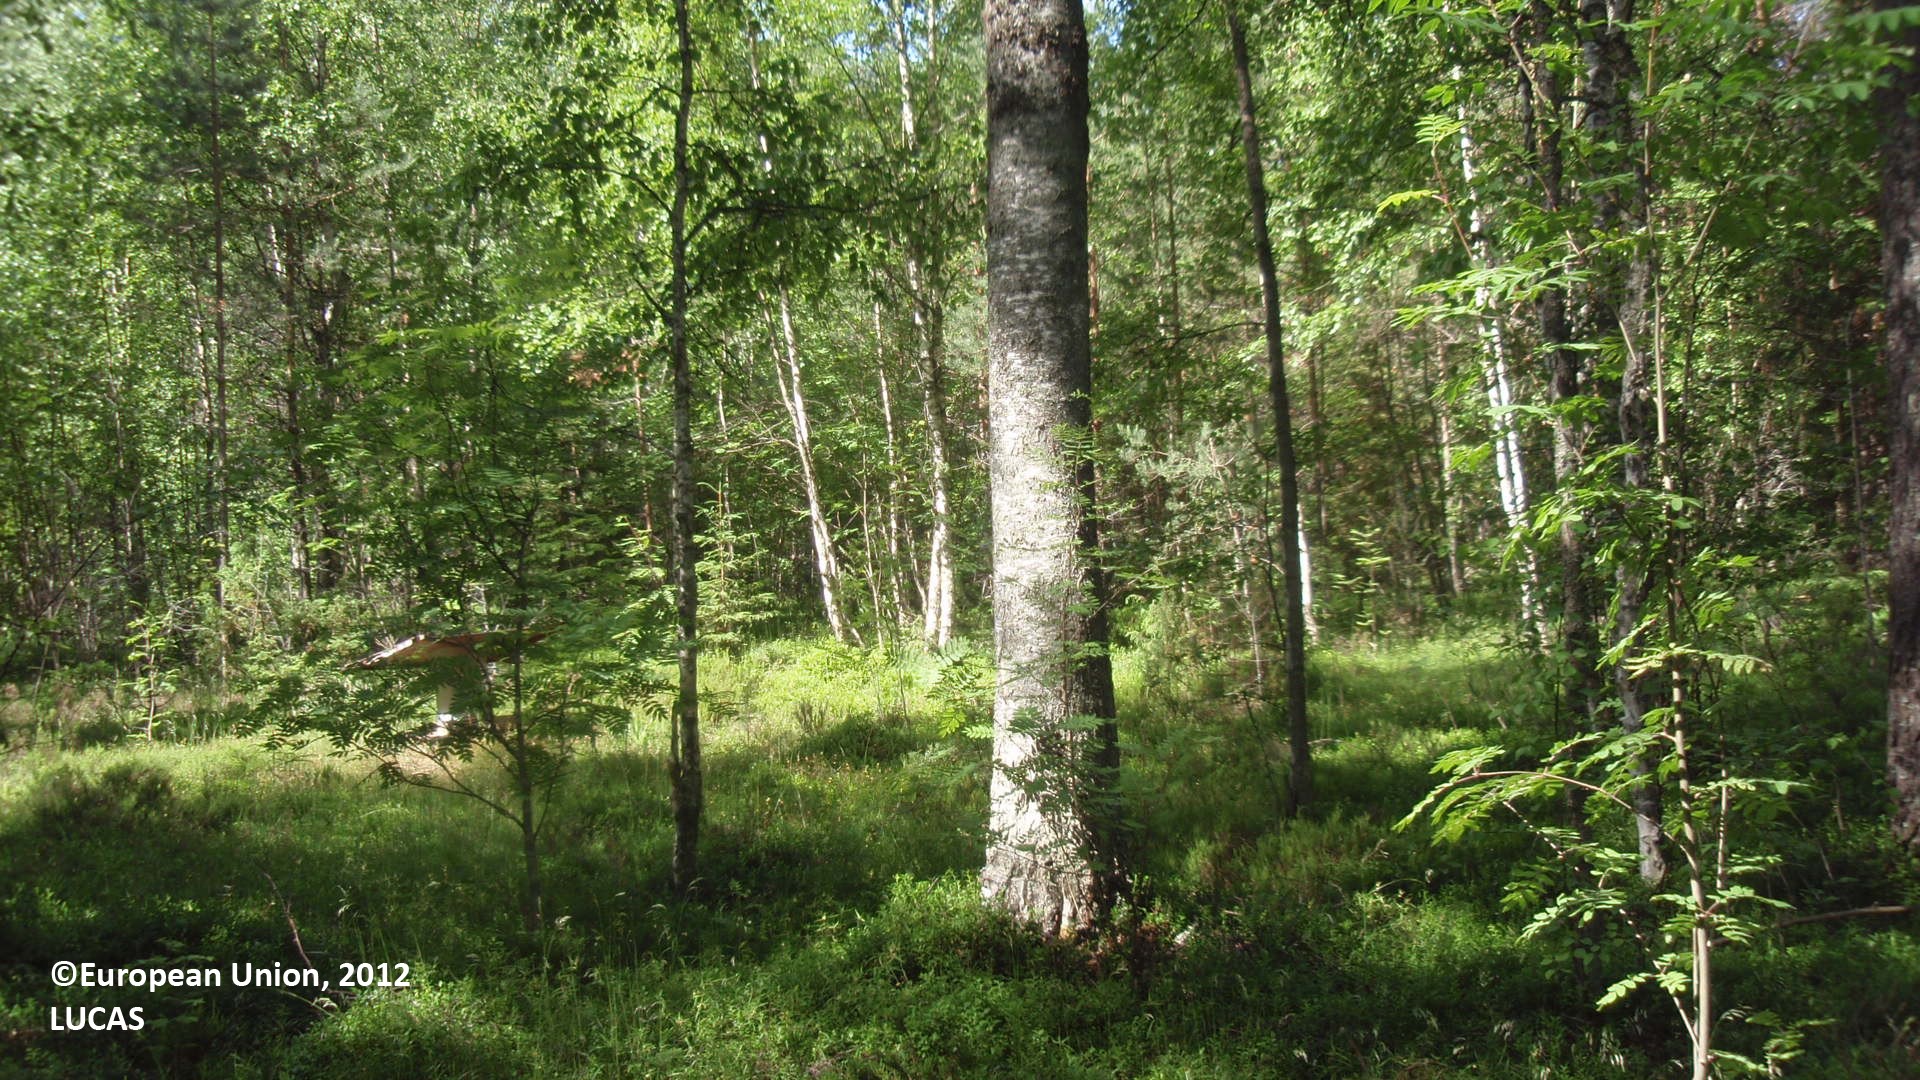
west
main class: Woodland
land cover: Pine dominated mixed woodland
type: boreal forest
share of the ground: 25 - 50 %
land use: Forestry
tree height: > 5 m
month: July
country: FI
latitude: 61.6728
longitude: 28.2032
